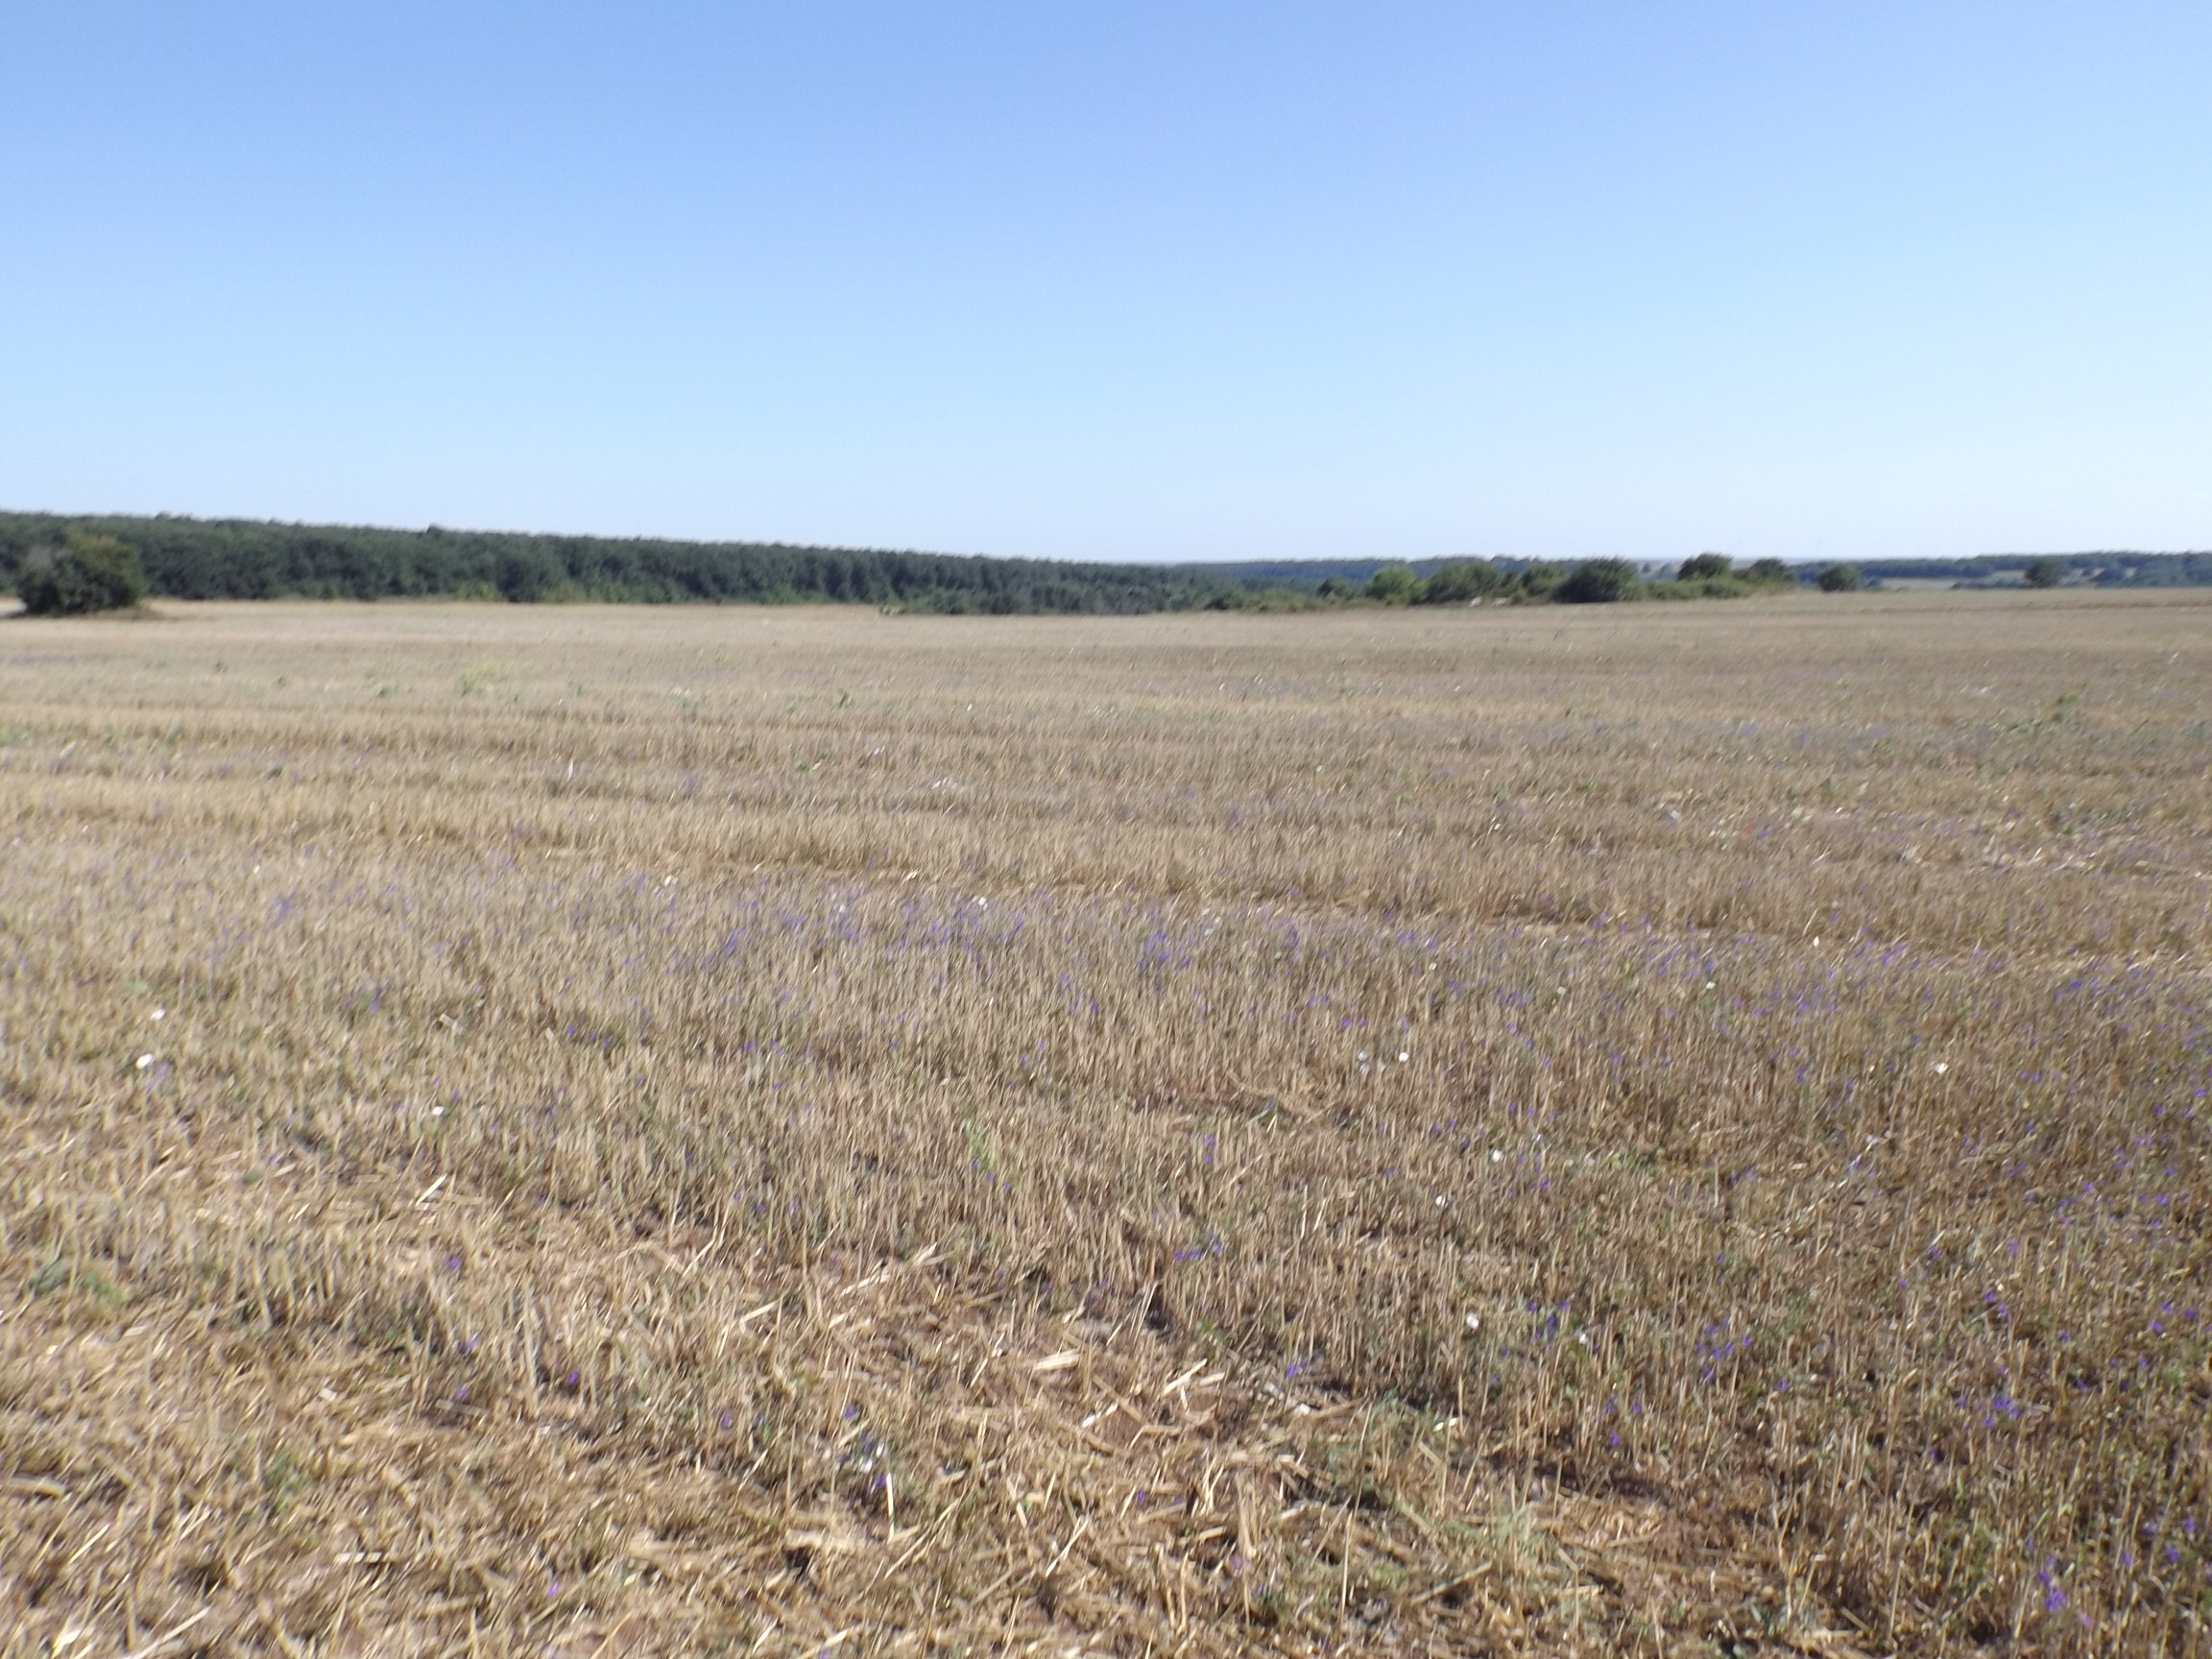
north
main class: Cropland
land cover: Common wheat
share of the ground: 10 - 25 %
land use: Agriculture (excluding fallow land and kitchen gardens)
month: August
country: BG
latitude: 43.3644
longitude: 27.9233
